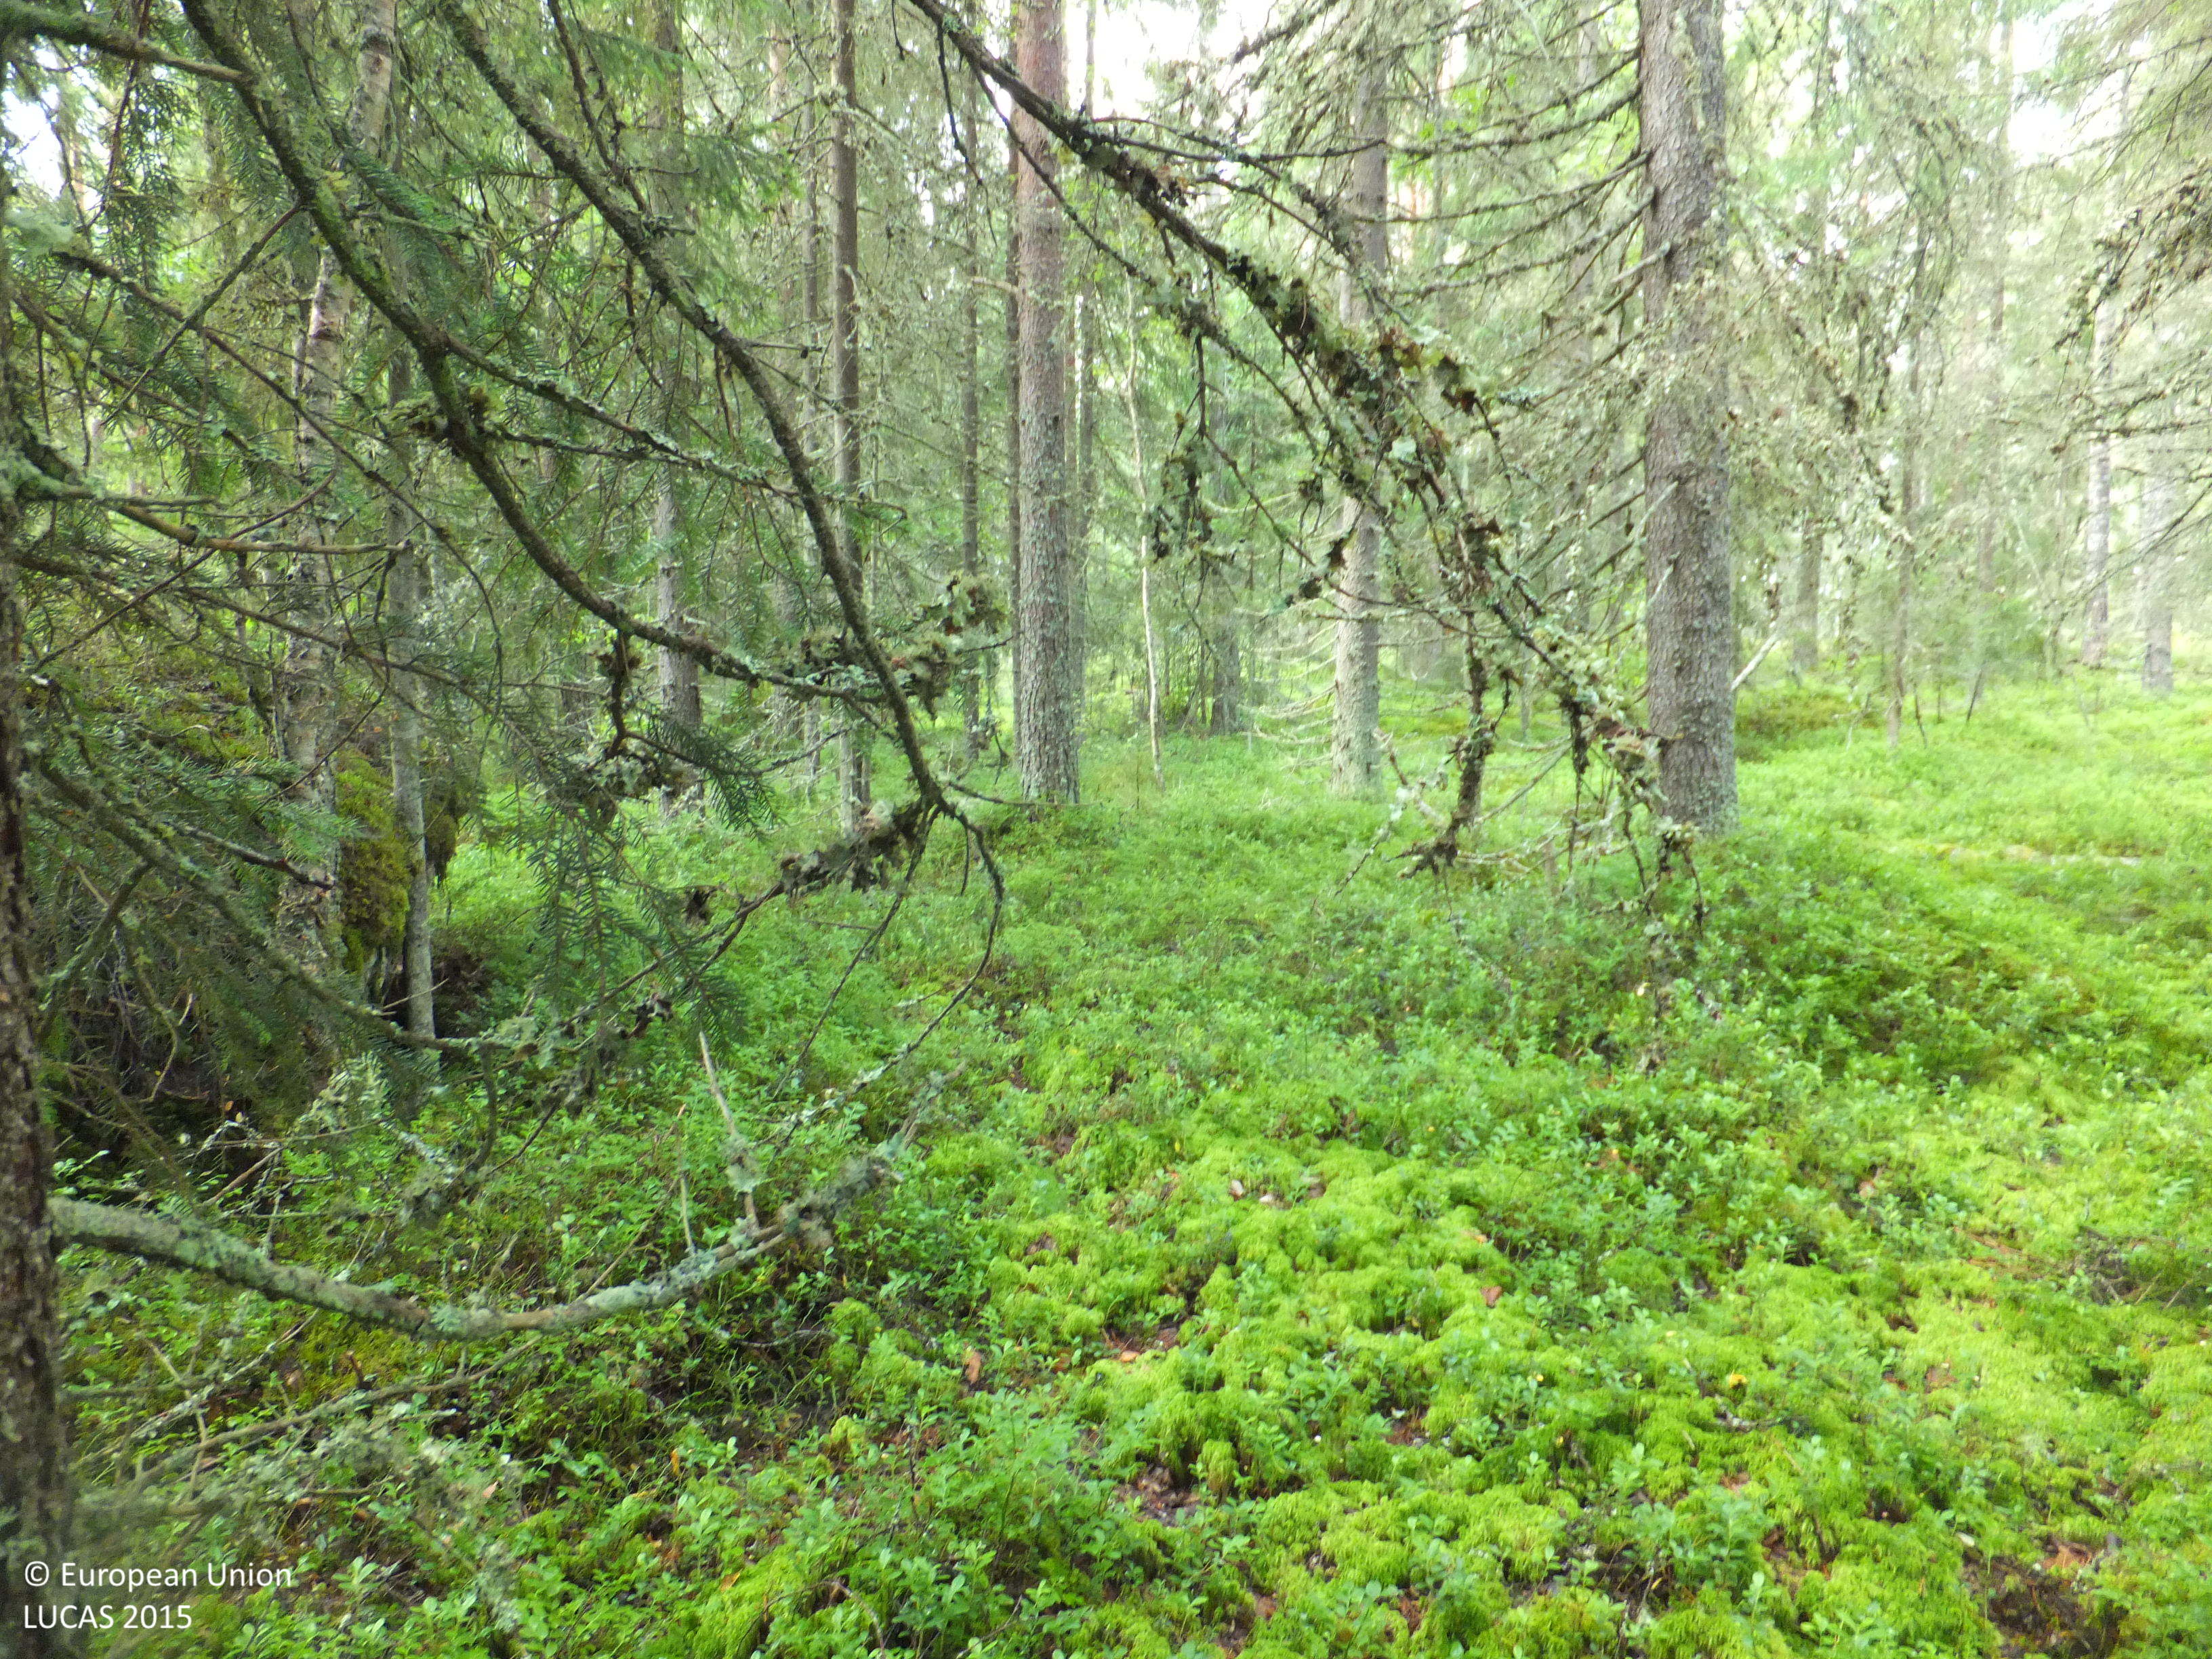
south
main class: Woodland
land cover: Other coniferous woodland
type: boreal forest
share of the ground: > 75 %
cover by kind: coniferous forest trees 85 %, broadleaved forest trees 5 %, shrubs 5 %, lichens and mosses 5 %
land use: Forestry
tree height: > 5 m
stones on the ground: < 10 %
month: July
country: FI
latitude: 63.1565
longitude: 21.9734
